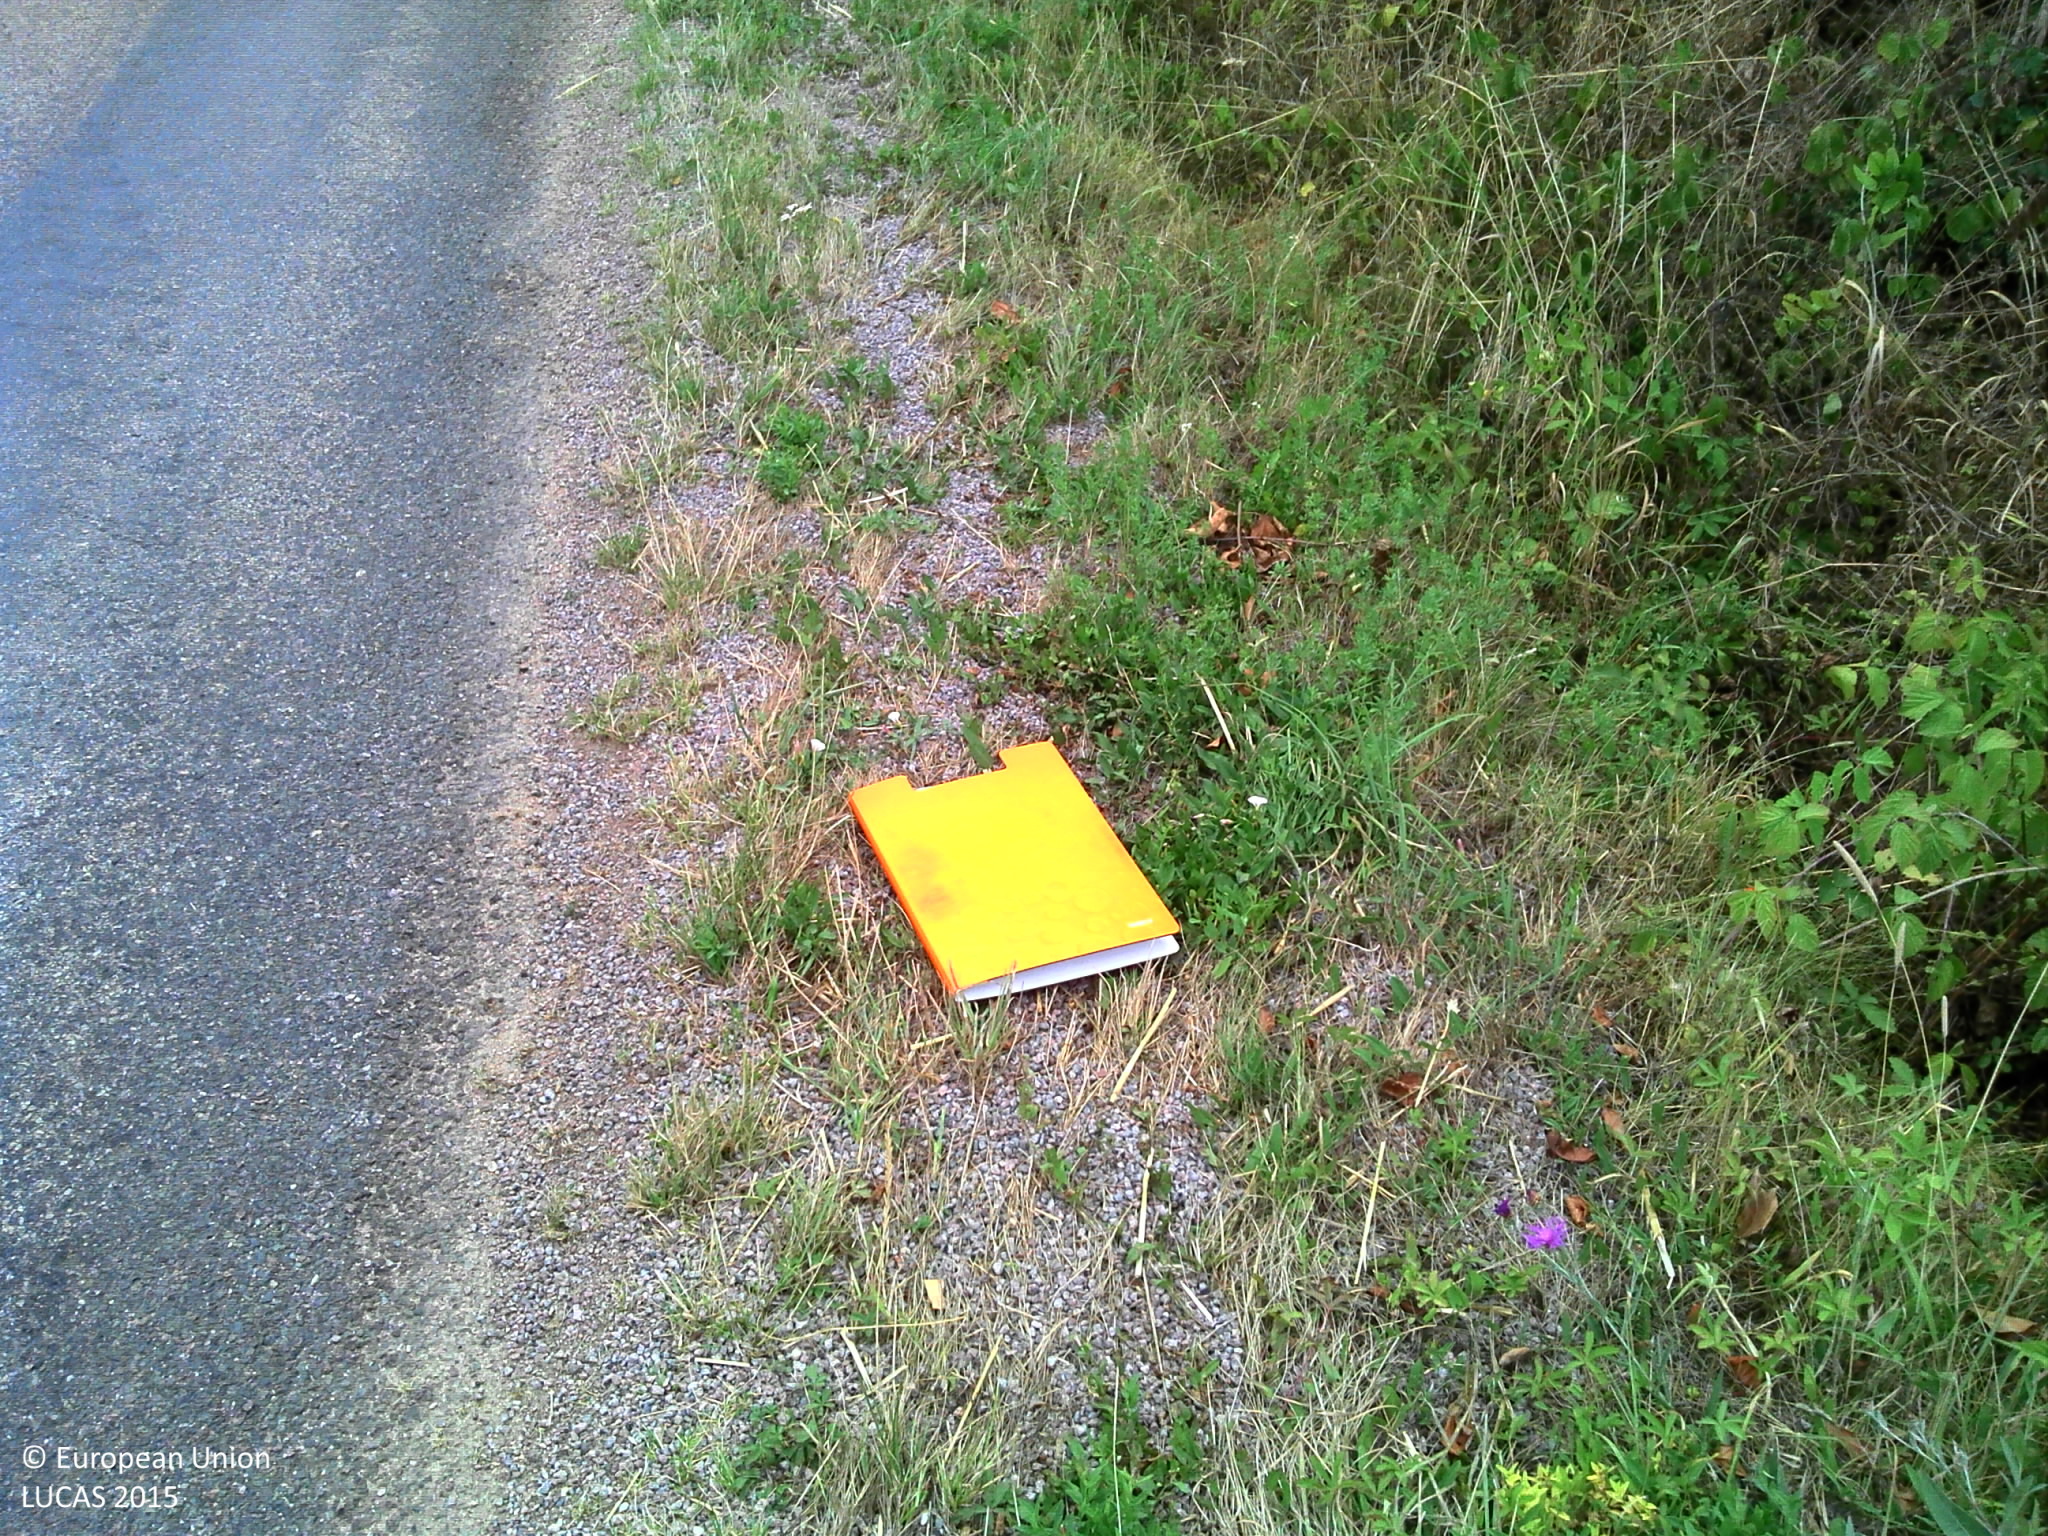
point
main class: Cropland
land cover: Other fresh vegetables
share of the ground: 50 - 75 %
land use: Kitchen garden
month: July
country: FR
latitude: 47.7578
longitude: 5.1840
